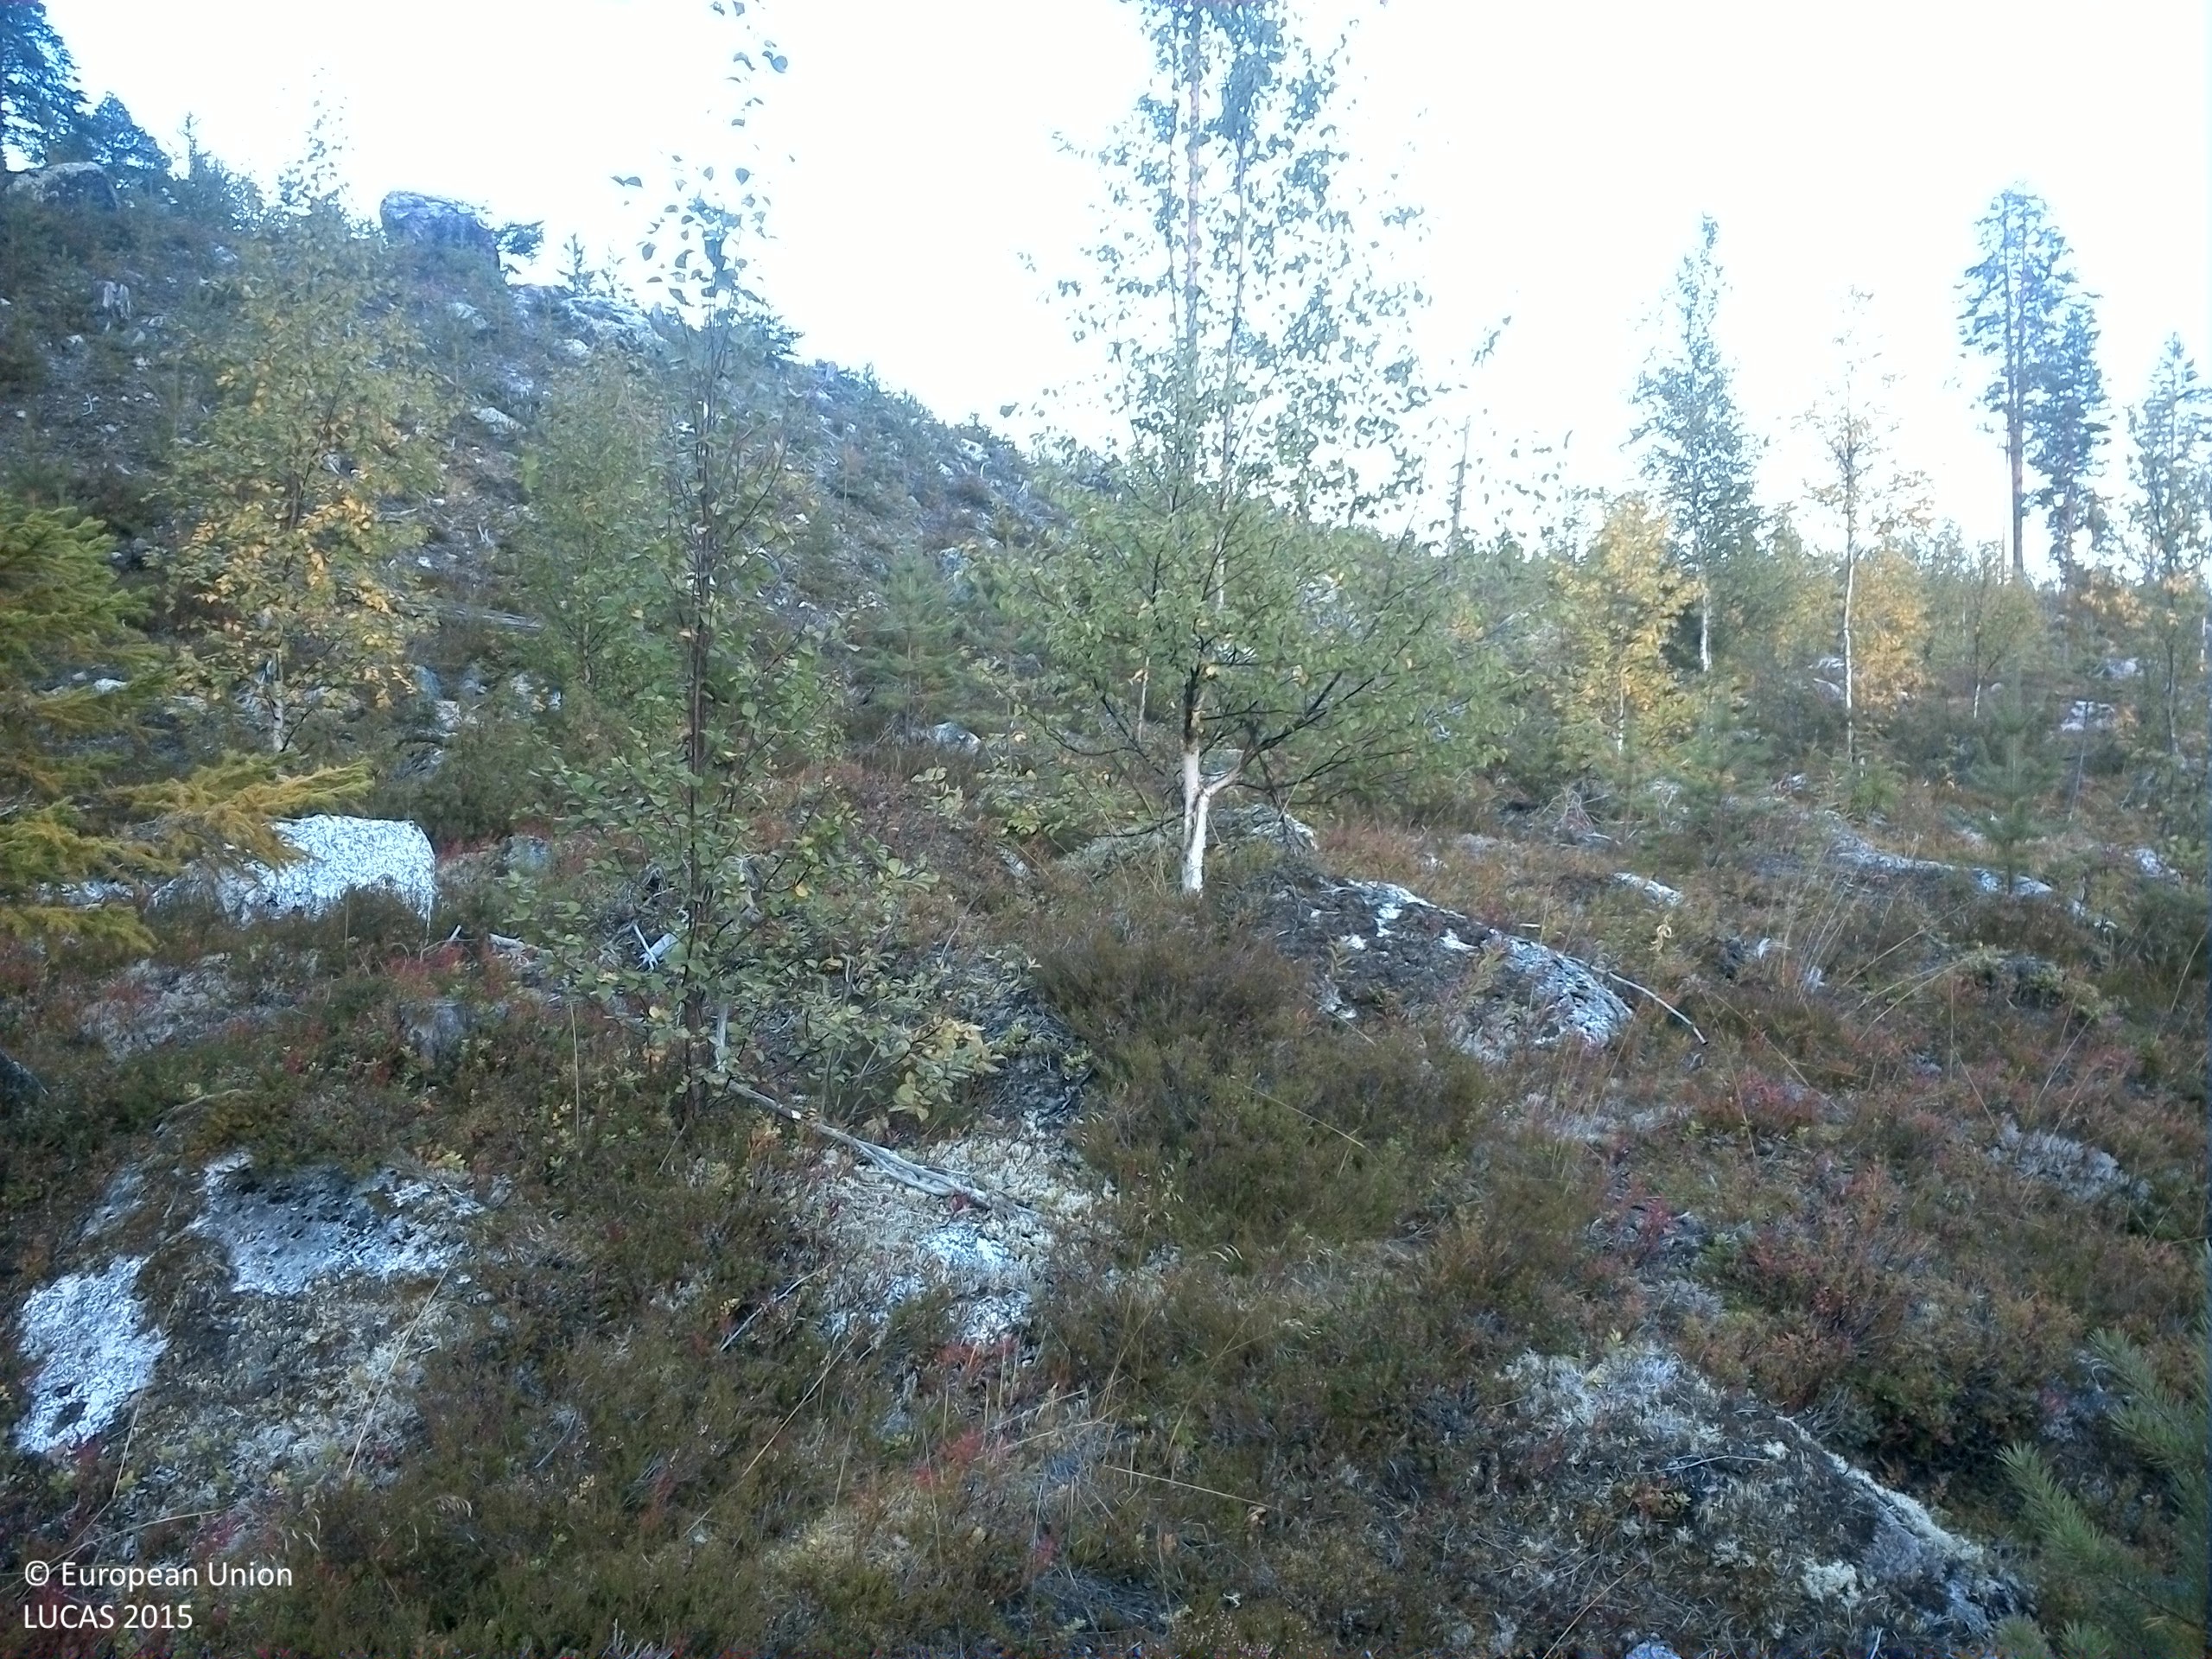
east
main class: Woodland
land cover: Pine dominated mixed woodland
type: boreal forest
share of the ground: 10 - 25 %
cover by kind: shrubs 45 %, lichens and mosses 25 %, coniferous forest trees 10 %, broadleaved forest trees 10 %, consolidated bare surface 10 %
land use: Forestry
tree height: < 5 m
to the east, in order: Pine dominated mixed woodland; Pine dominated coniferous woodland; Pine dominated mixed woodland
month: September
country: SE
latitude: 63.9183
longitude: 16.5561
